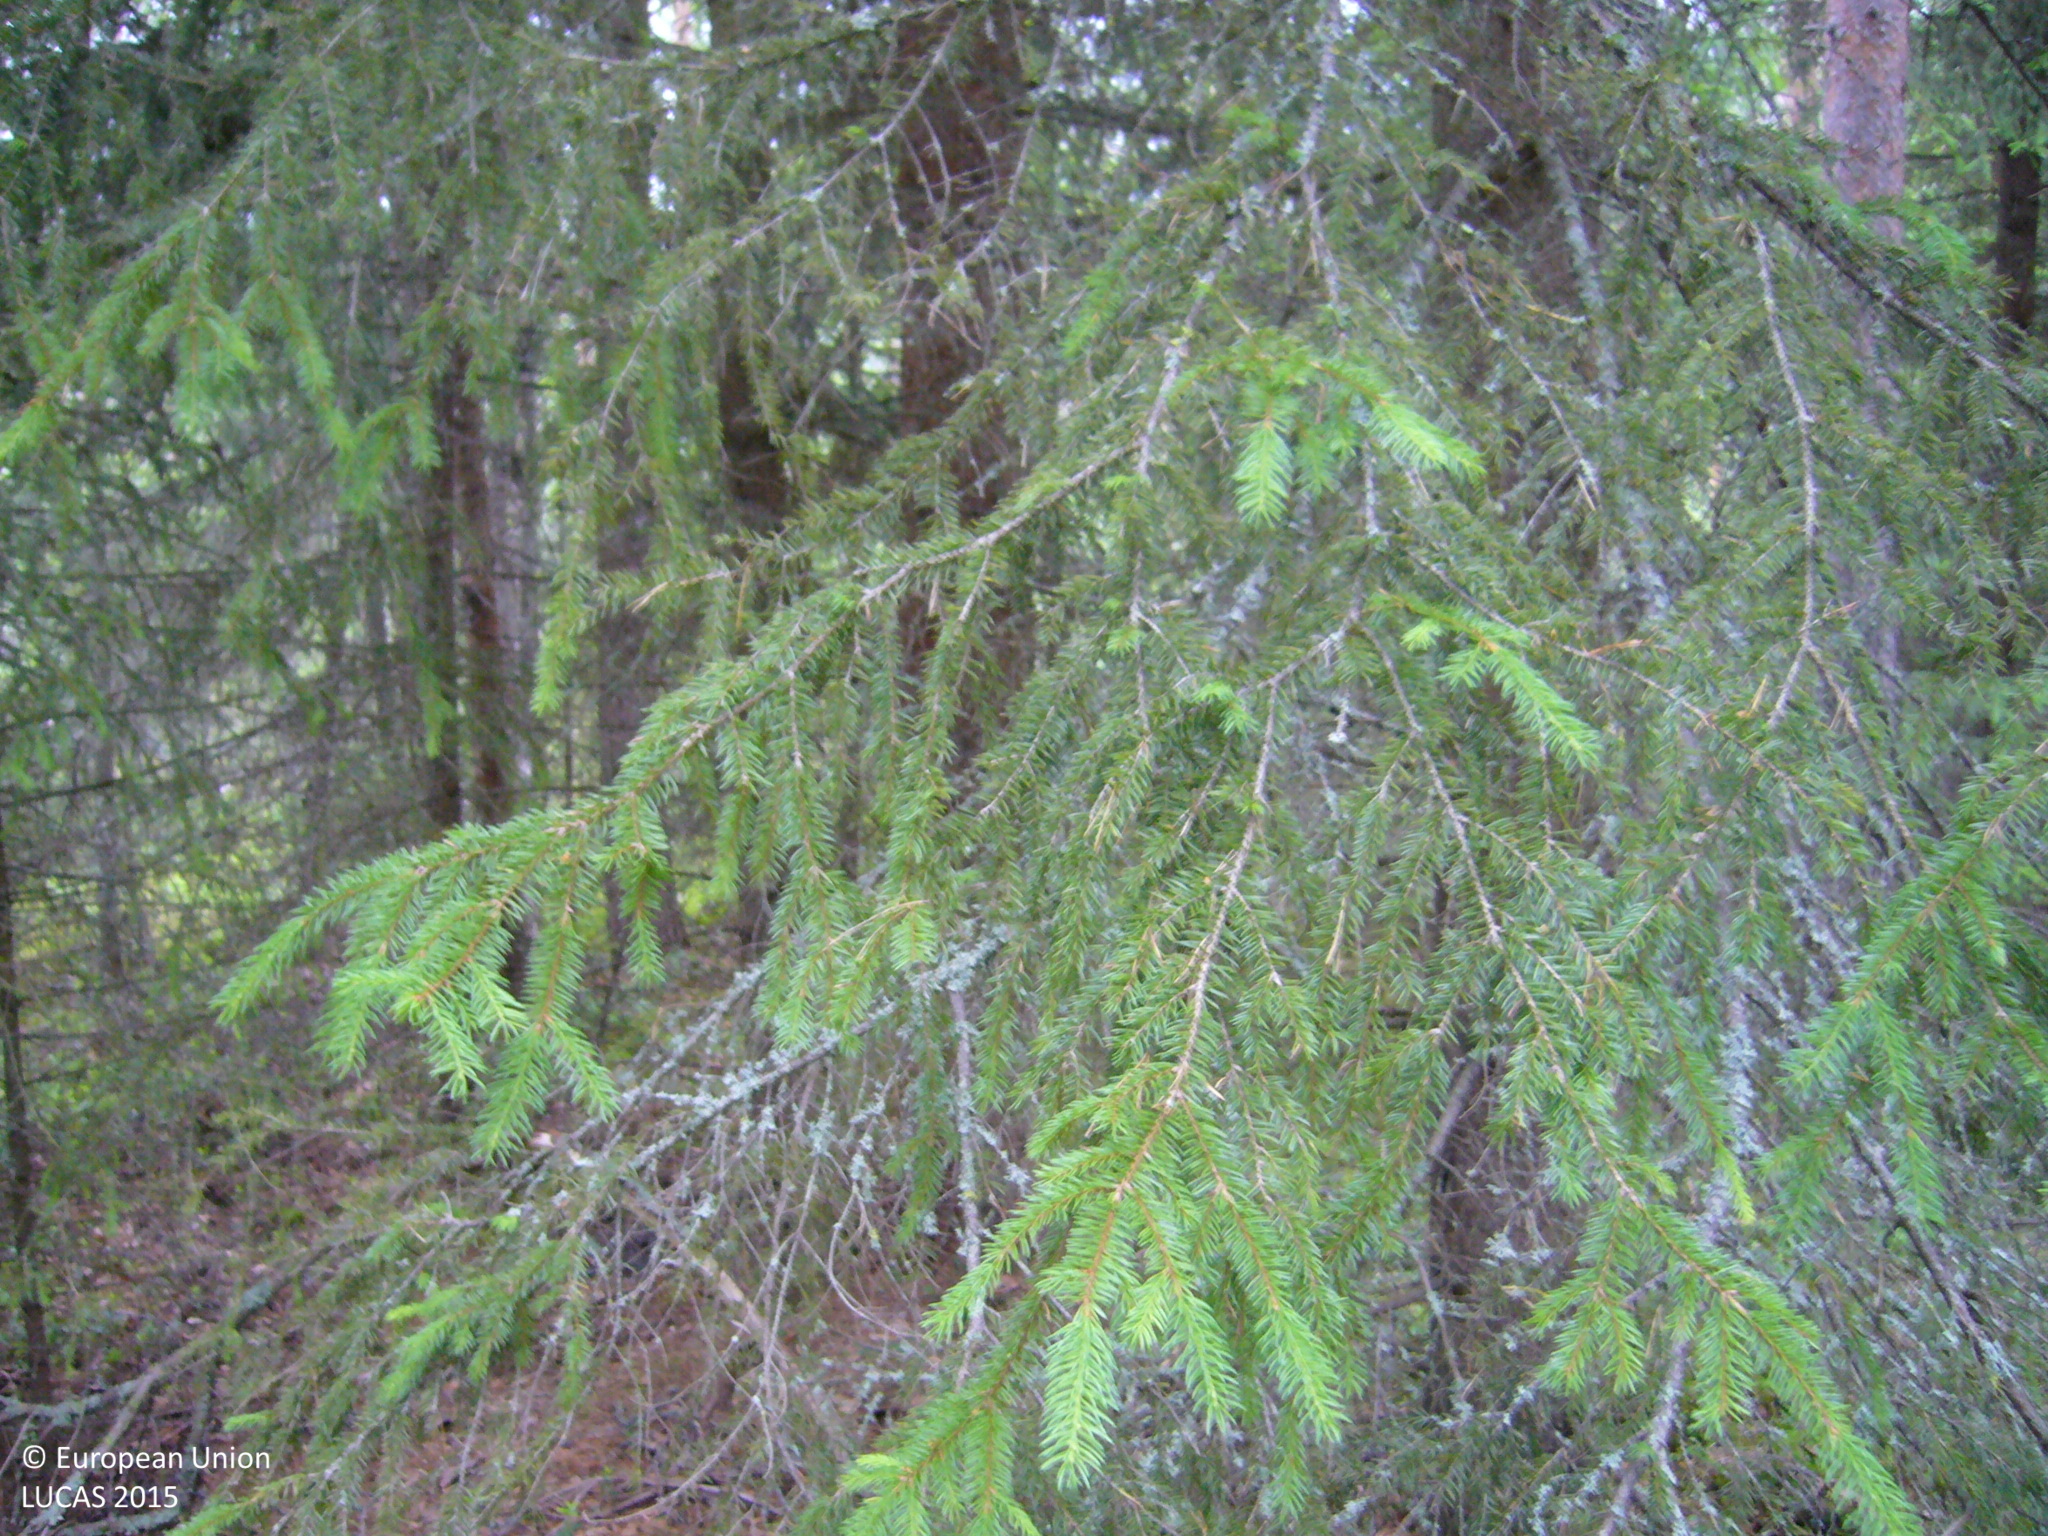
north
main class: Woodland
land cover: Pine dominated mixed woodland
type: boreal forest
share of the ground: > 75 %
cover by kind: coniferous forest trees 50 %, broadleaved forest trees 25 %, shrubs 25 %
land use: Forestry
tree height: > 5 m
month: July
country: FI
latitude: 63.4275
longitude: 26.3741
